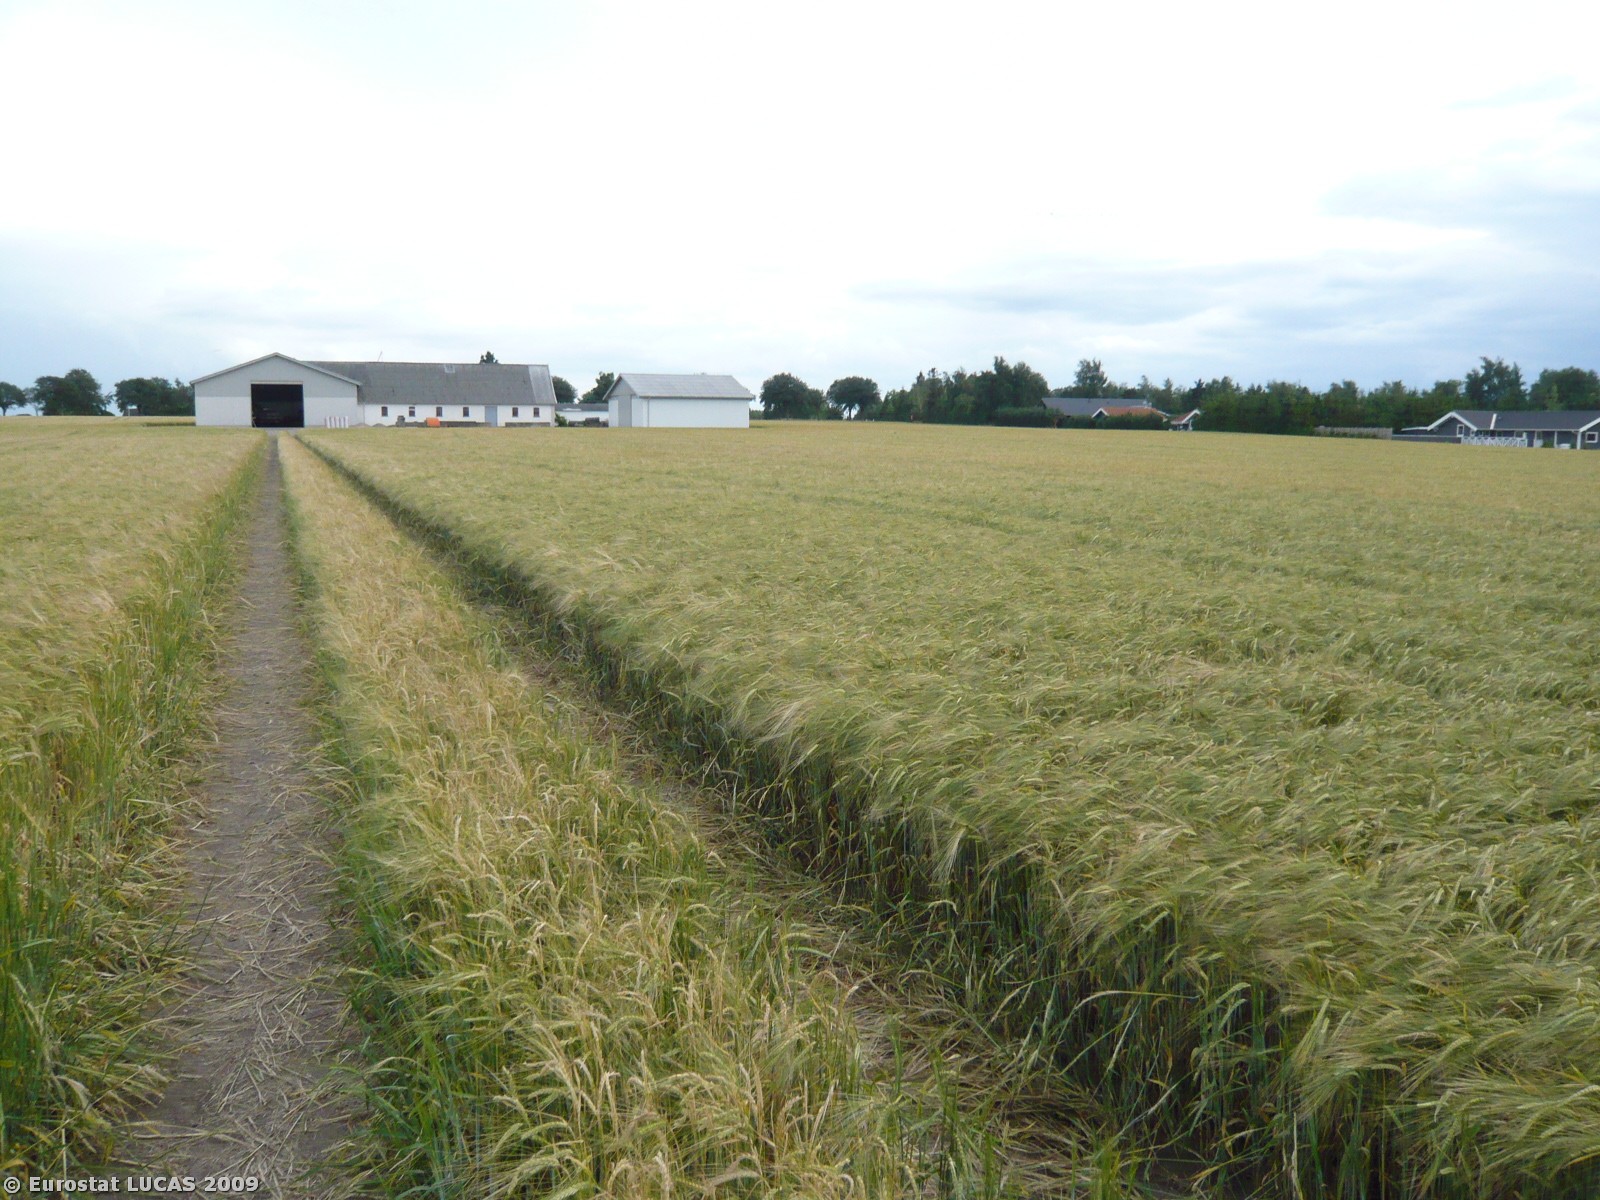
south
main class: Cropland
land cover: Barley
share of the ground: > 75 %
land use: Agriculture (excluding fallow land and kitchen gardens)
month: July
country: DK
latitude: 55.4449
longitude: 11.2162
